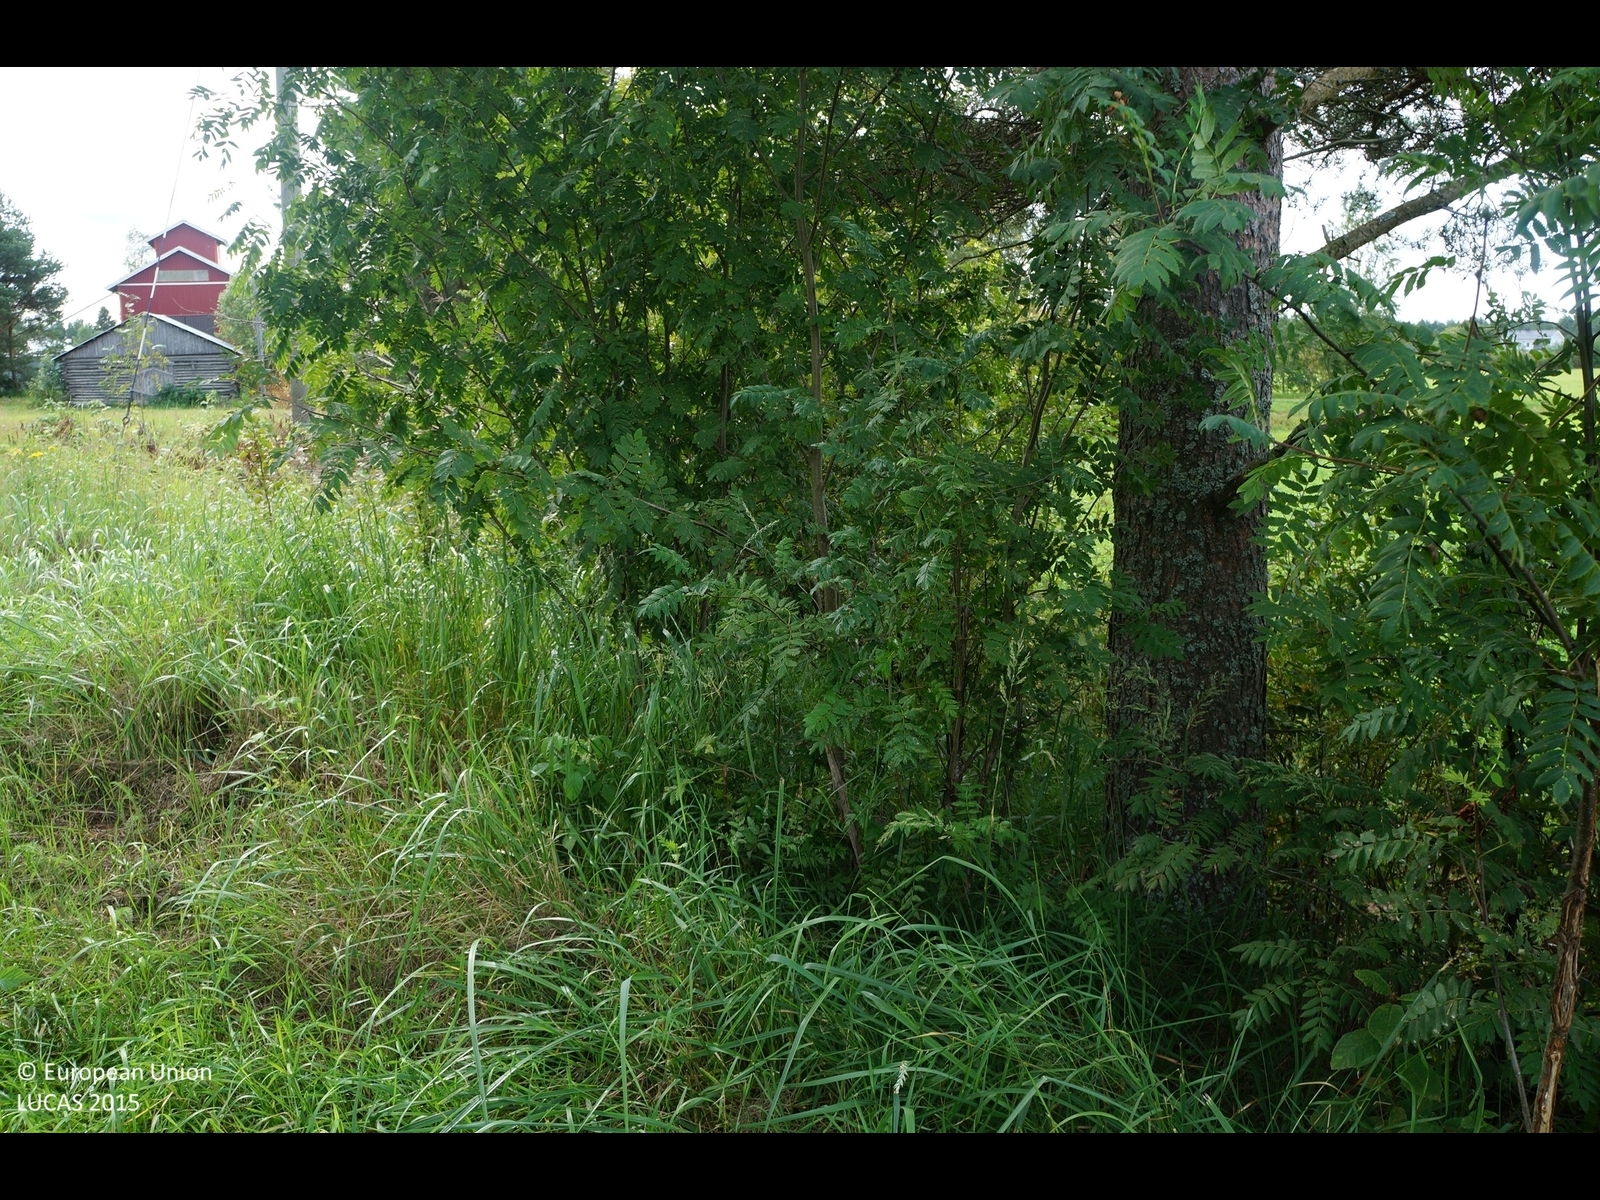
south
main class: Cropland
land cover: Temporary grasslands
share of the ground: > 75 %
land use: Agriculture (excluding fallow land and kitchen gardens)
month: August
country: FI
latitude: 64.8284
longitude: 24.7572
